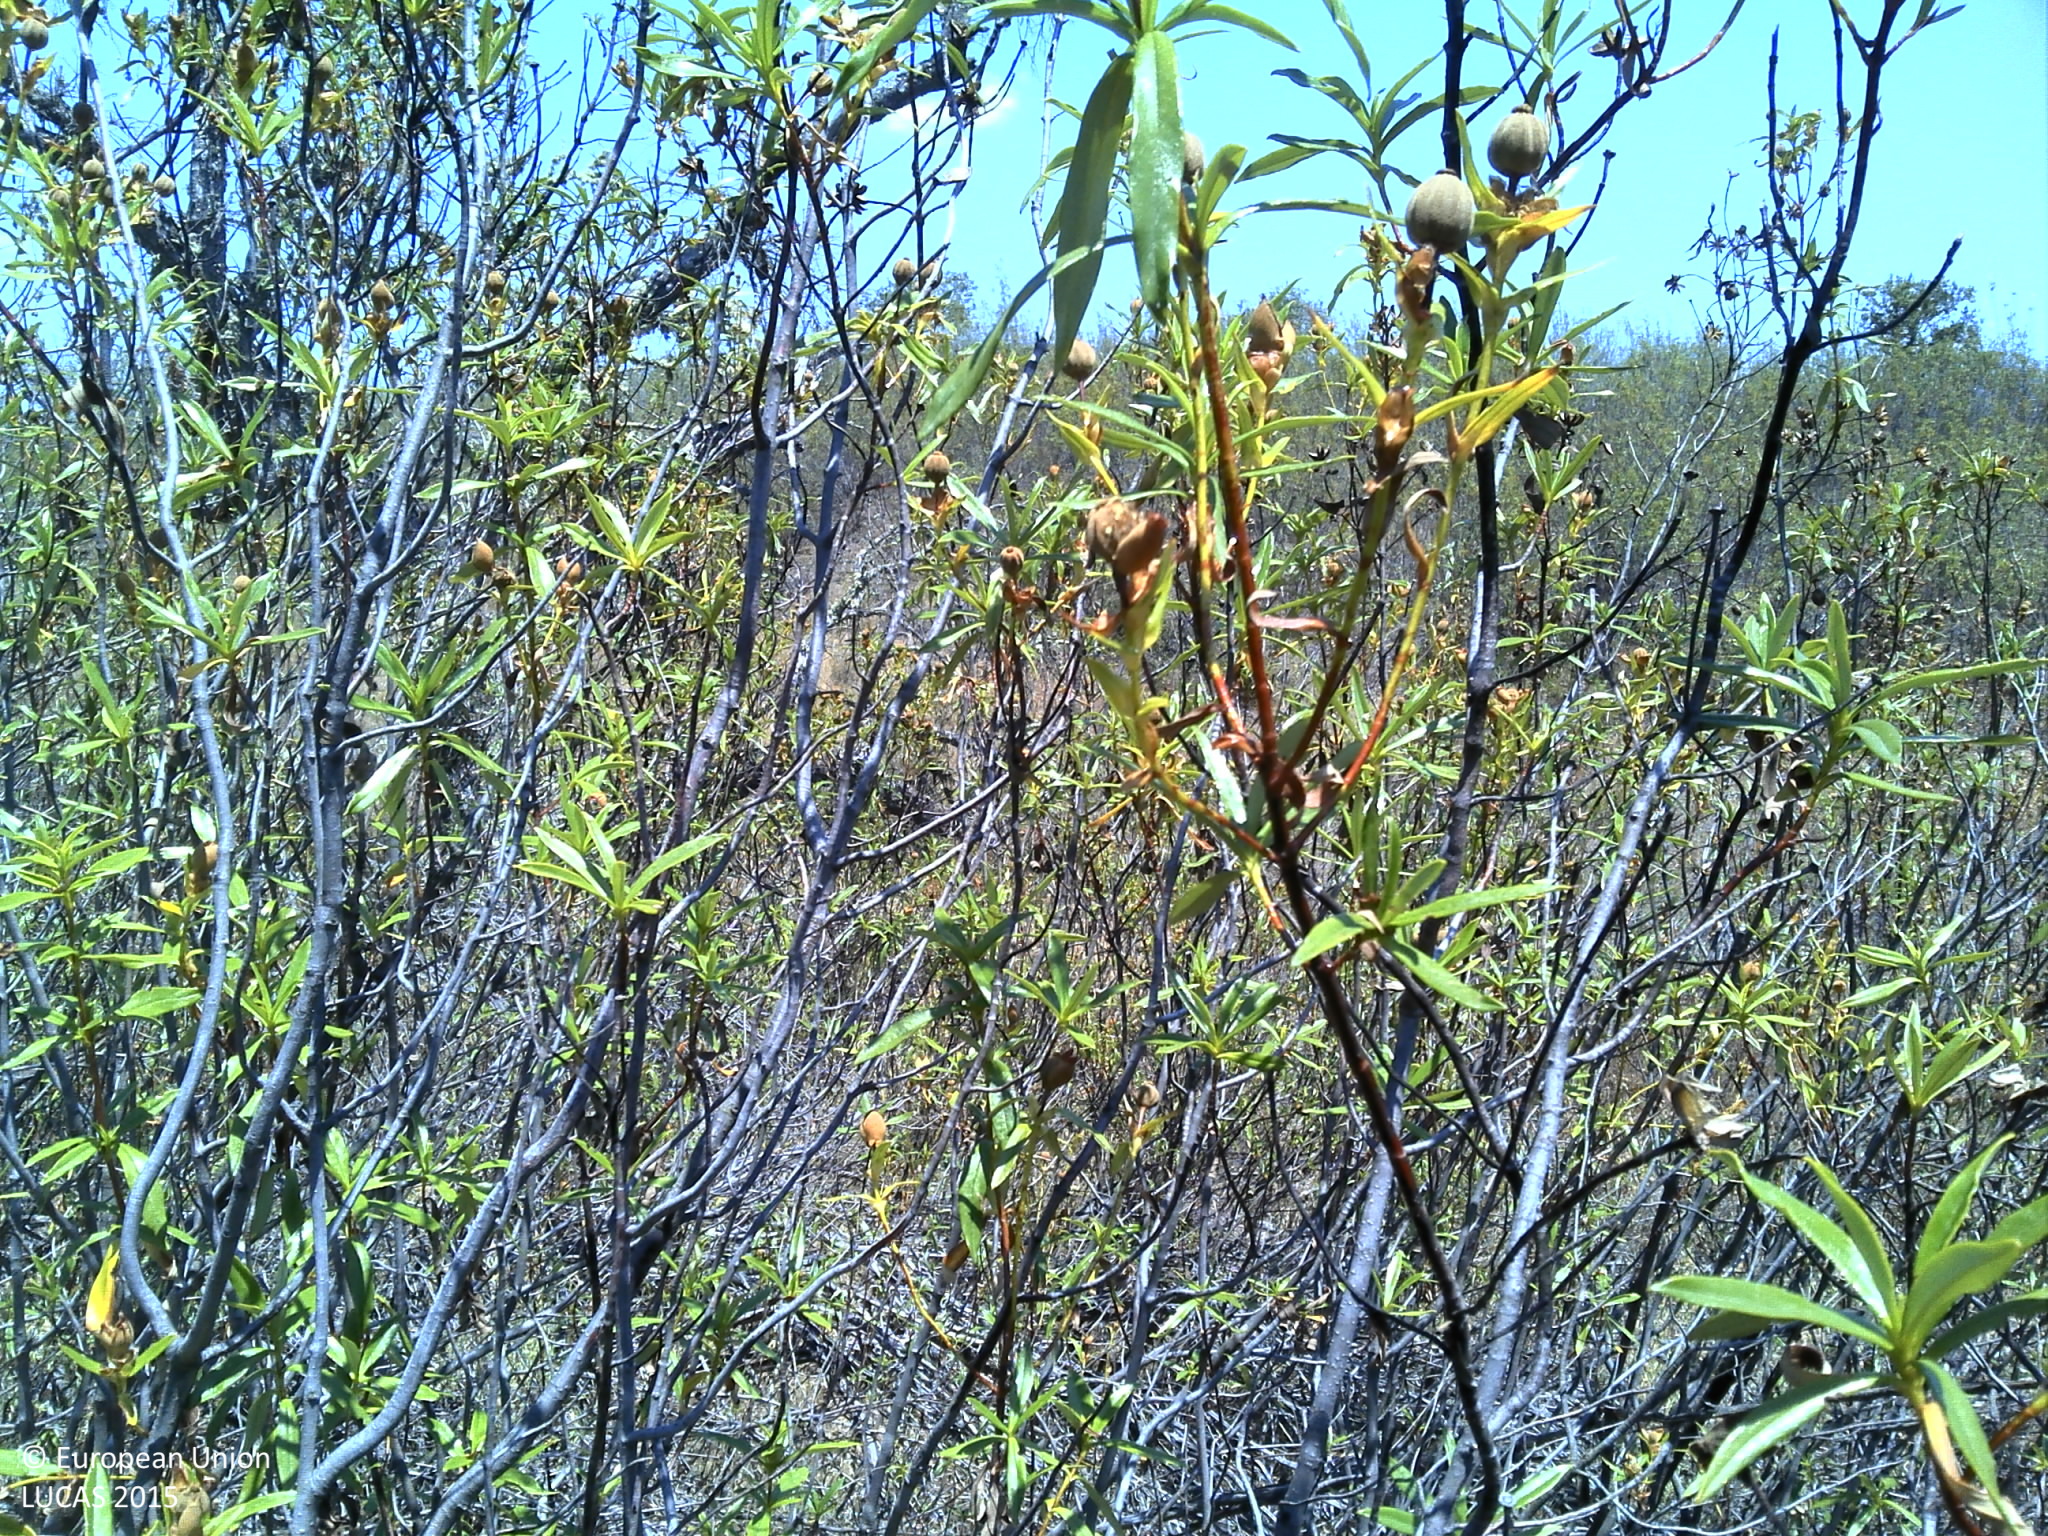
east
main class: Shrubland
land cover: Shrubland with sparse tree cover
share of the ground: > 75 %
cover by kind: shrubs 85 %, unconsolidated bare surface 10 %, broadleaved forest trees 5 %
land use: Abandoned areas
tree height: < 5 m
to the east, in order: Shrubland with sparse tree cover; Rivers and streams; Shruby margins; Grassland without tree/shrub cover; Shrubland without tree cover; Other structural elements; Shrubland without tree cover; Grassland without tree/shrub cover; Shrubland with sparse tree cover; Grassland without tree/shrub cover; Dry stone walls; Ditches and canals; Shrubland without tree cover; Shrubland with sparse tree cover
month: June
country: PT
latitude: 37.3907
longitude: -7.8727
